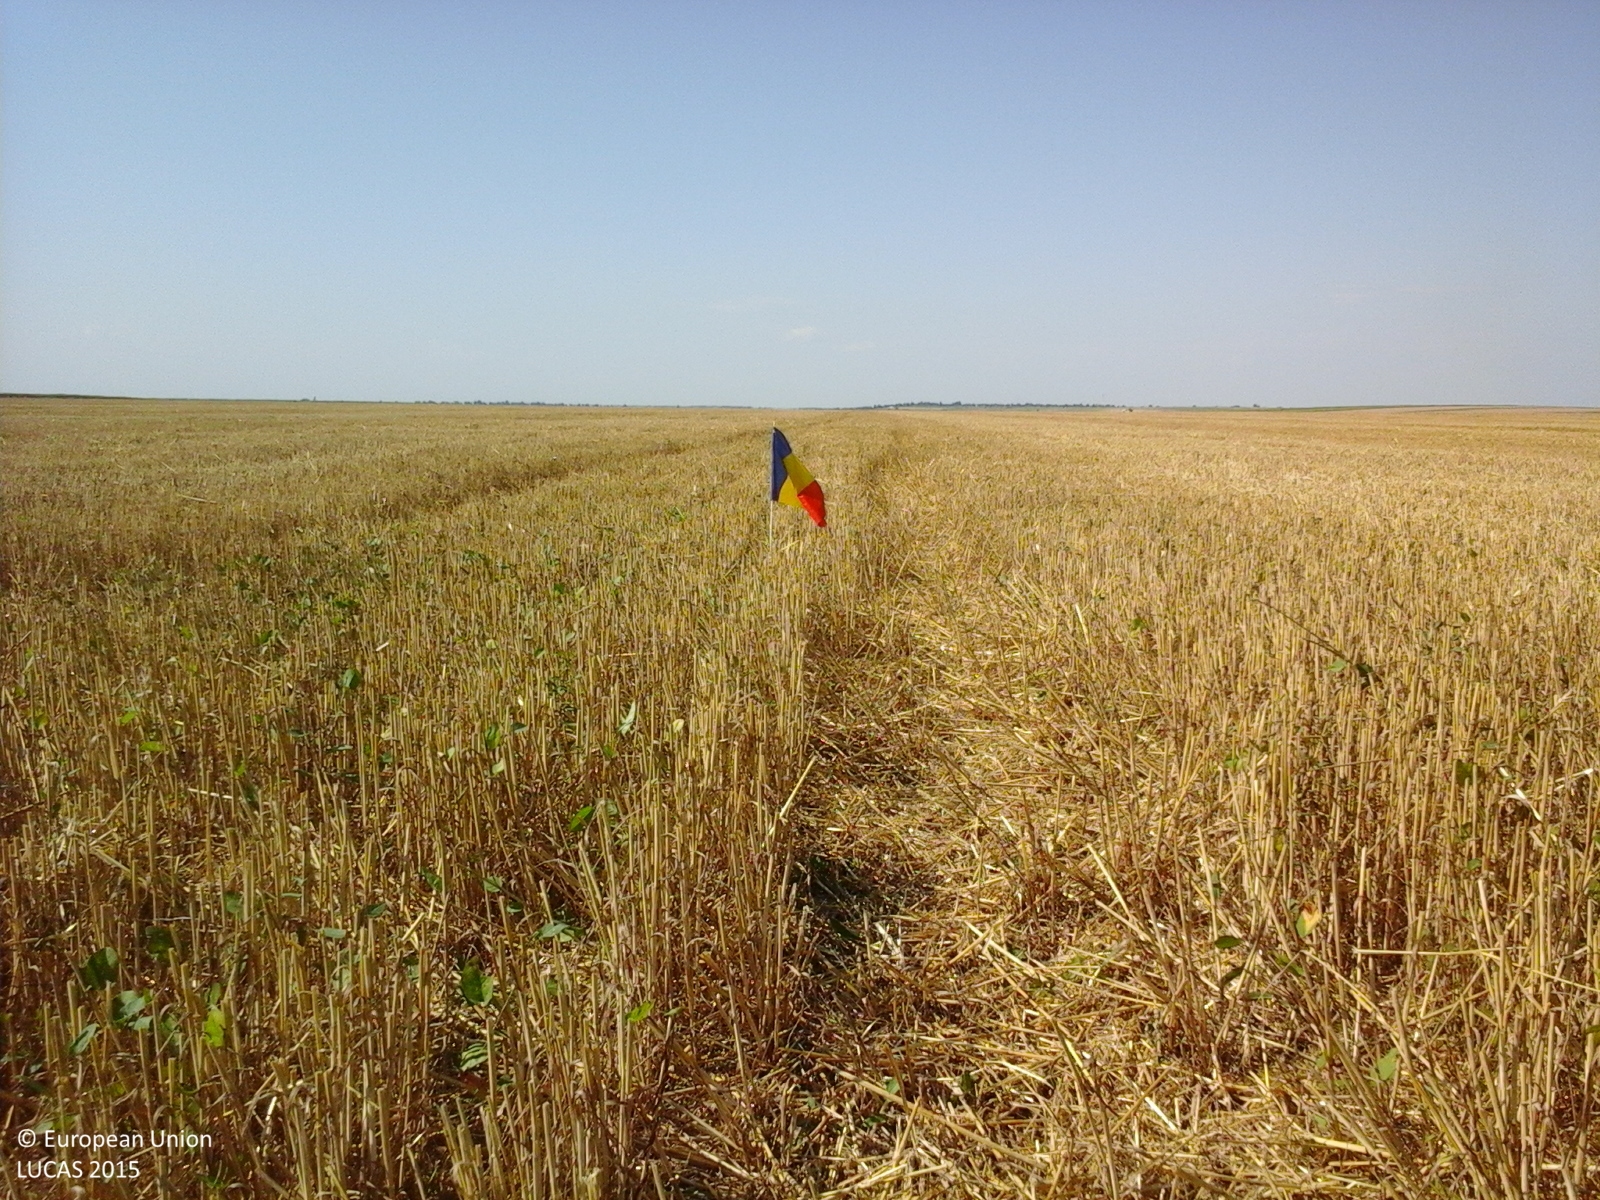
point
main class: Cropland
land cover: Common wheat
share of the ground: 50 - 75 %
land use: Agriculture (excluding fallow land and kitchen gardens)
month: July
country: RO
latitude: 44.2188
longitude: 24.5261
